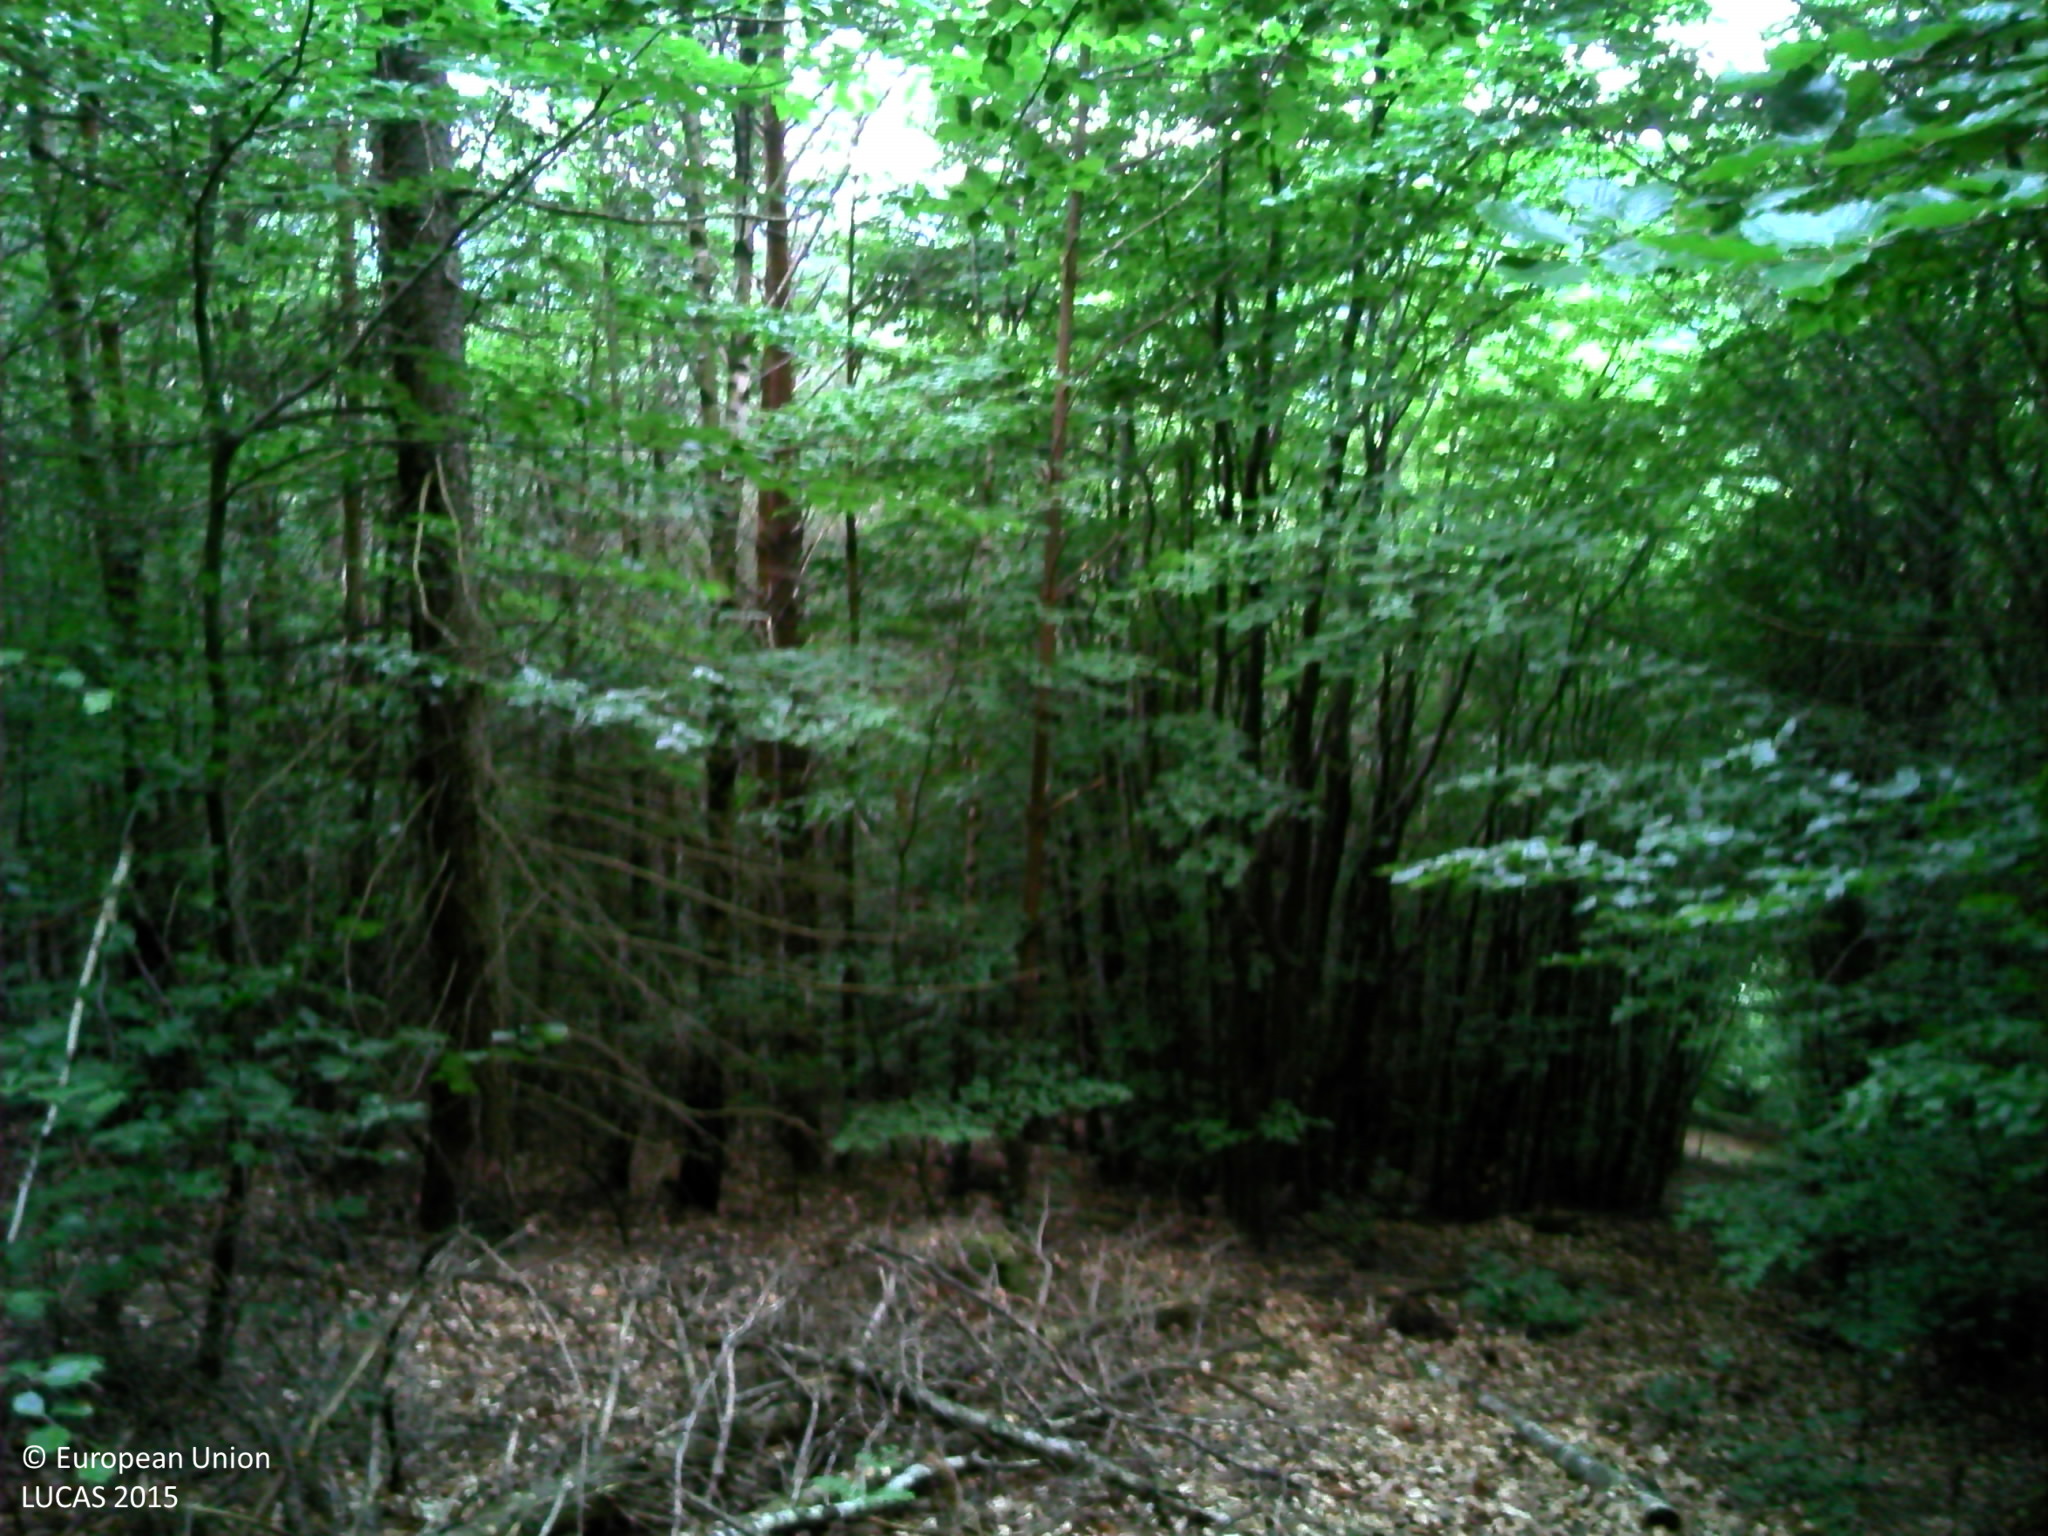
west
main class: Woodland
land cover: Broadleaved woodland
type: beech forest
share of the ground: > 75 %
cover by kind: broadleaved forest trees 75 %, coniferous forest trees 15 %, shrubs 5 %, herbaceous plants 5 %
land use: Forestry
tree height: > 5 m
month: June
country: FR
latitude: 49.0453
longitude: 7.6885
